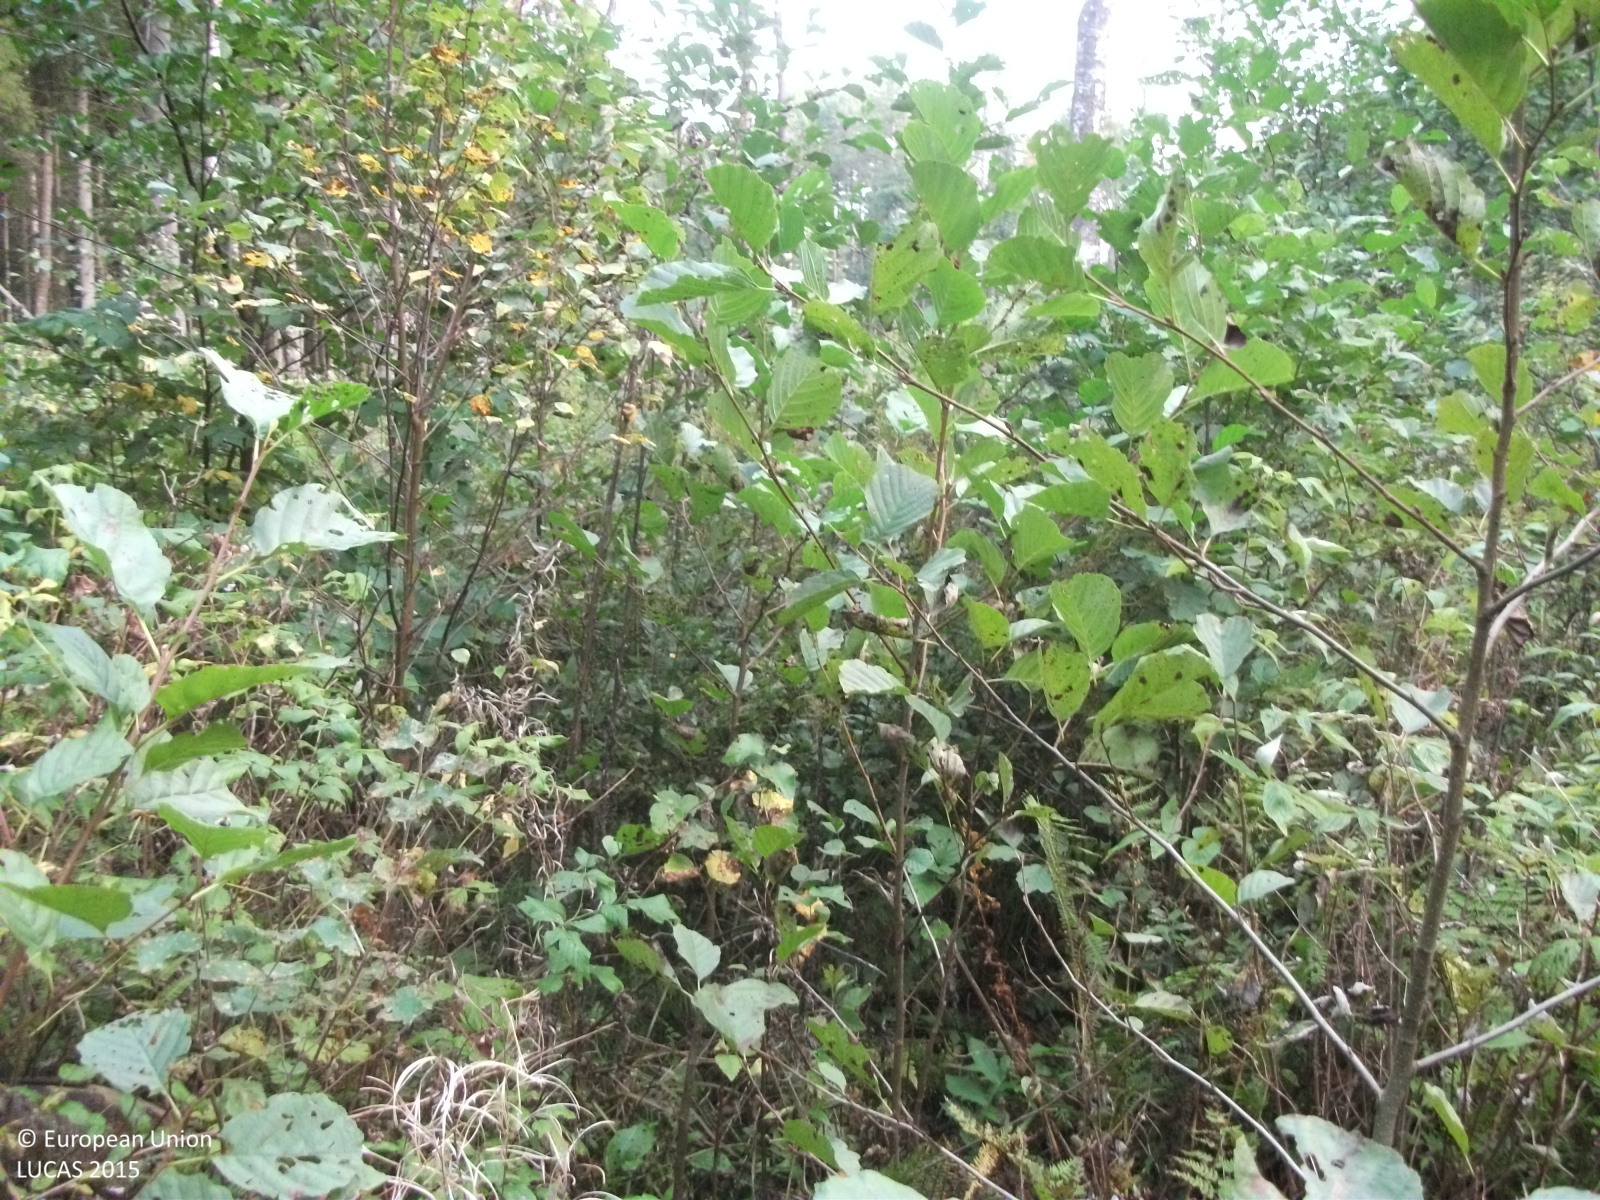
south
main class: Woodland
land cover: Broadleaved woodland
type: non-riverine alder, birch or aspen forest
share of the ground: 25 - 50 %
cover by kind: shrubs 50 %, broadleaved forest trees 40 %, herbaceous plants 10 %
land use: Forestry
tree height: < 5 m
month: September
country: LV
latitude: 57.8982
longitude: 24.5486
